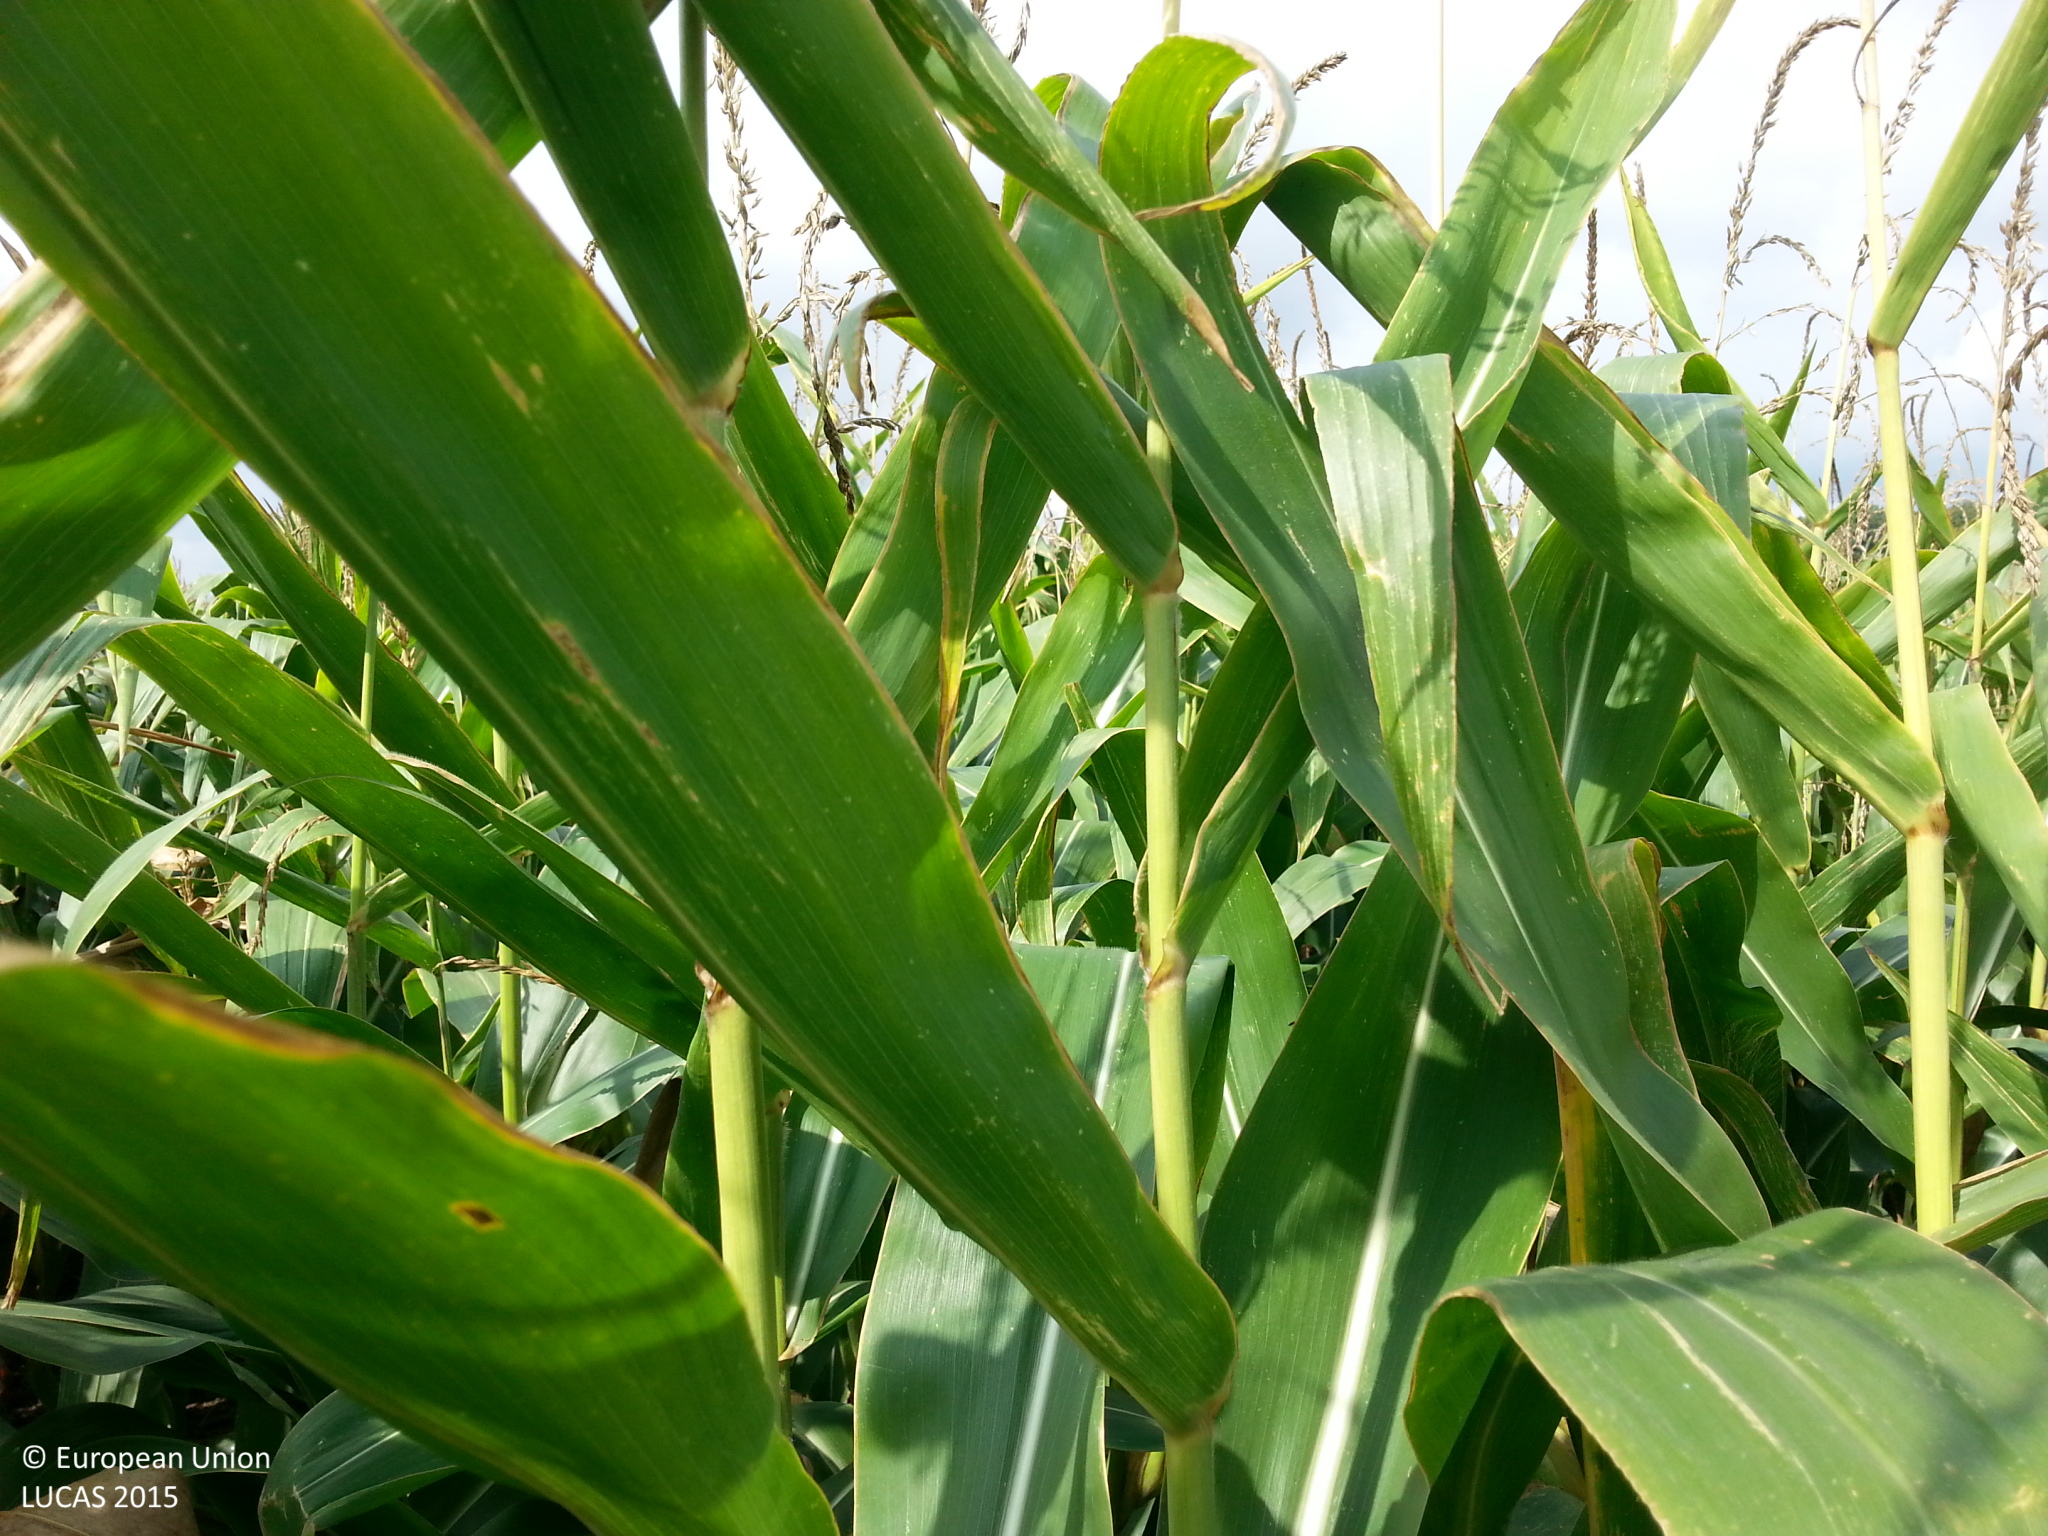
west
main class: Cropland
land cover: Maize
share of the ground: > 75 %
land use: Agriculture (excluding fallow land and kitchen gardens)
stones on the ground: < 10 %
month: September
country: DE
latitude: 49.3389
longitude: 9.9312
